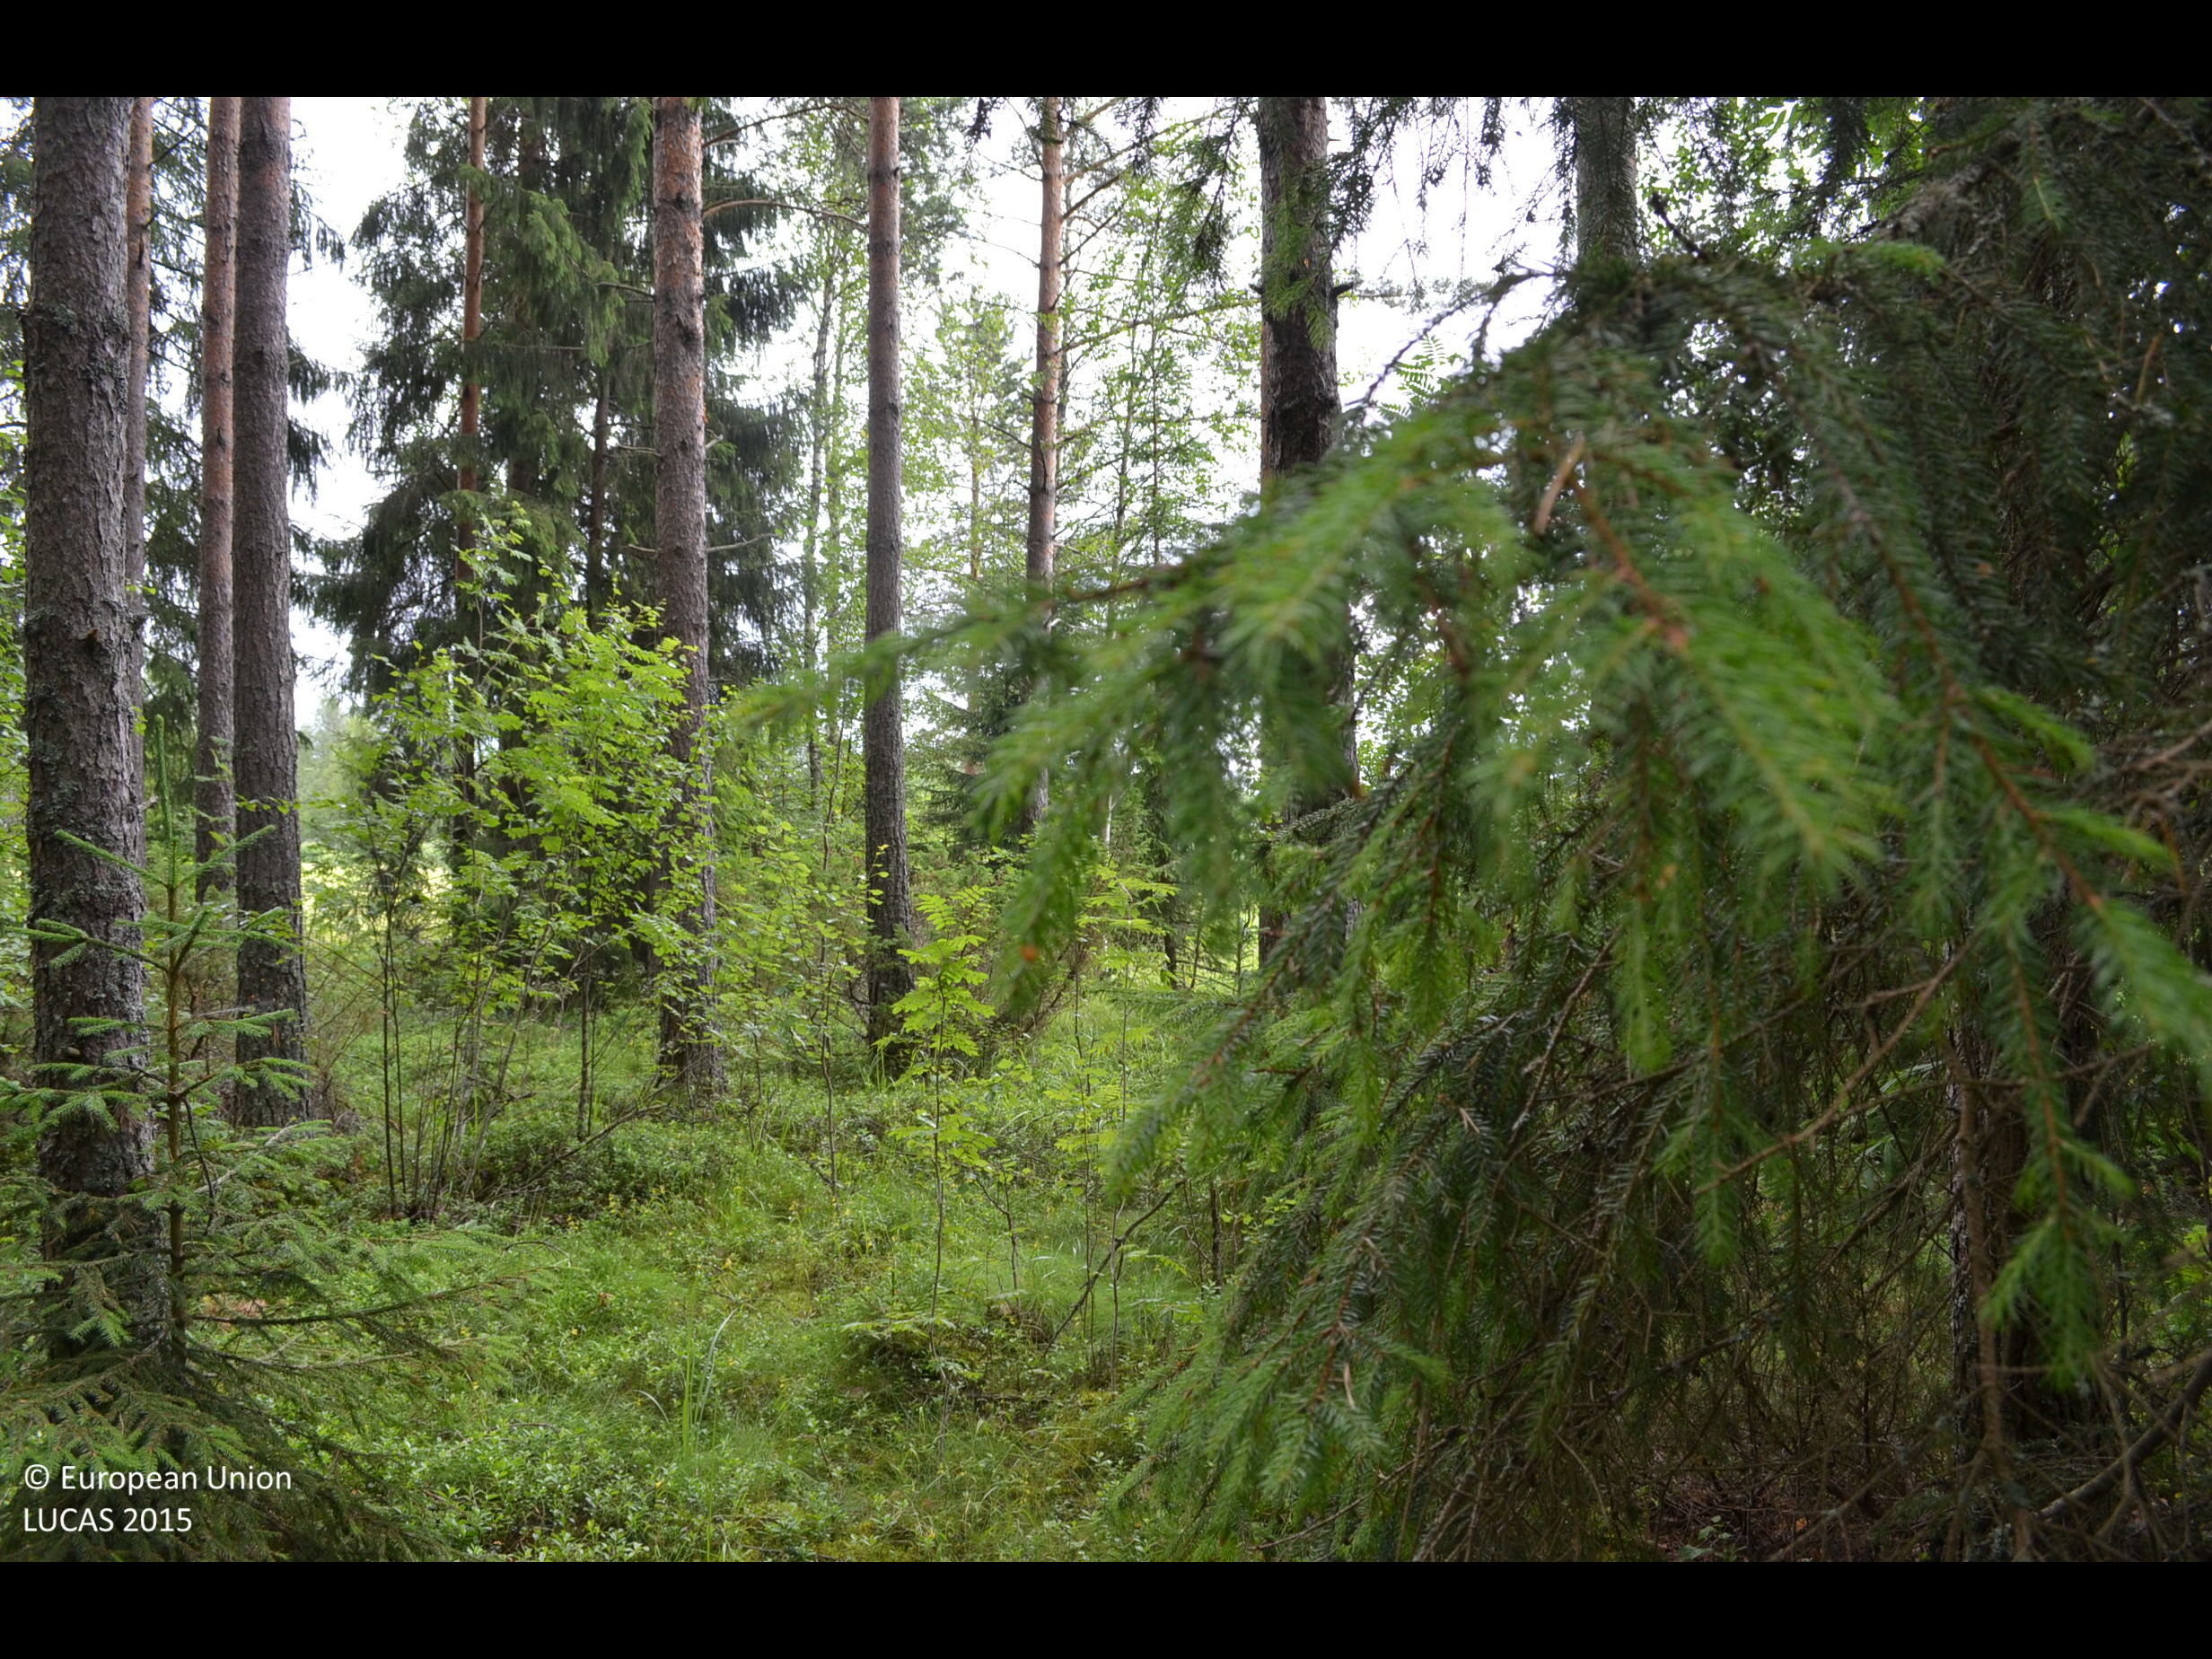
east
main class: Woodland
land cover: Pine dominated coniferous woodland
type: boreal forest
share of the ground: > 75 %
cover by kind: coniferous forest trees 80 %, broadleaved forest trees 10 %, shrubs 10 %
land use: Forestry
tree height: > 5 m
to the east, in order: Pine dominated coniferous woodland; Ditches and canals; Temporary grasslands; Grassland without tree/shrub cover; Rivers and streams; Grassland with sparse tree/shrub cover; Barley; Grass margins; Ditches and canals; Grass margins; Tracks; Grass margins; Ditches and canals; Grass margins; Barley
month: July
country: FI
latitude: 62.2863
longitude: 23.5861
